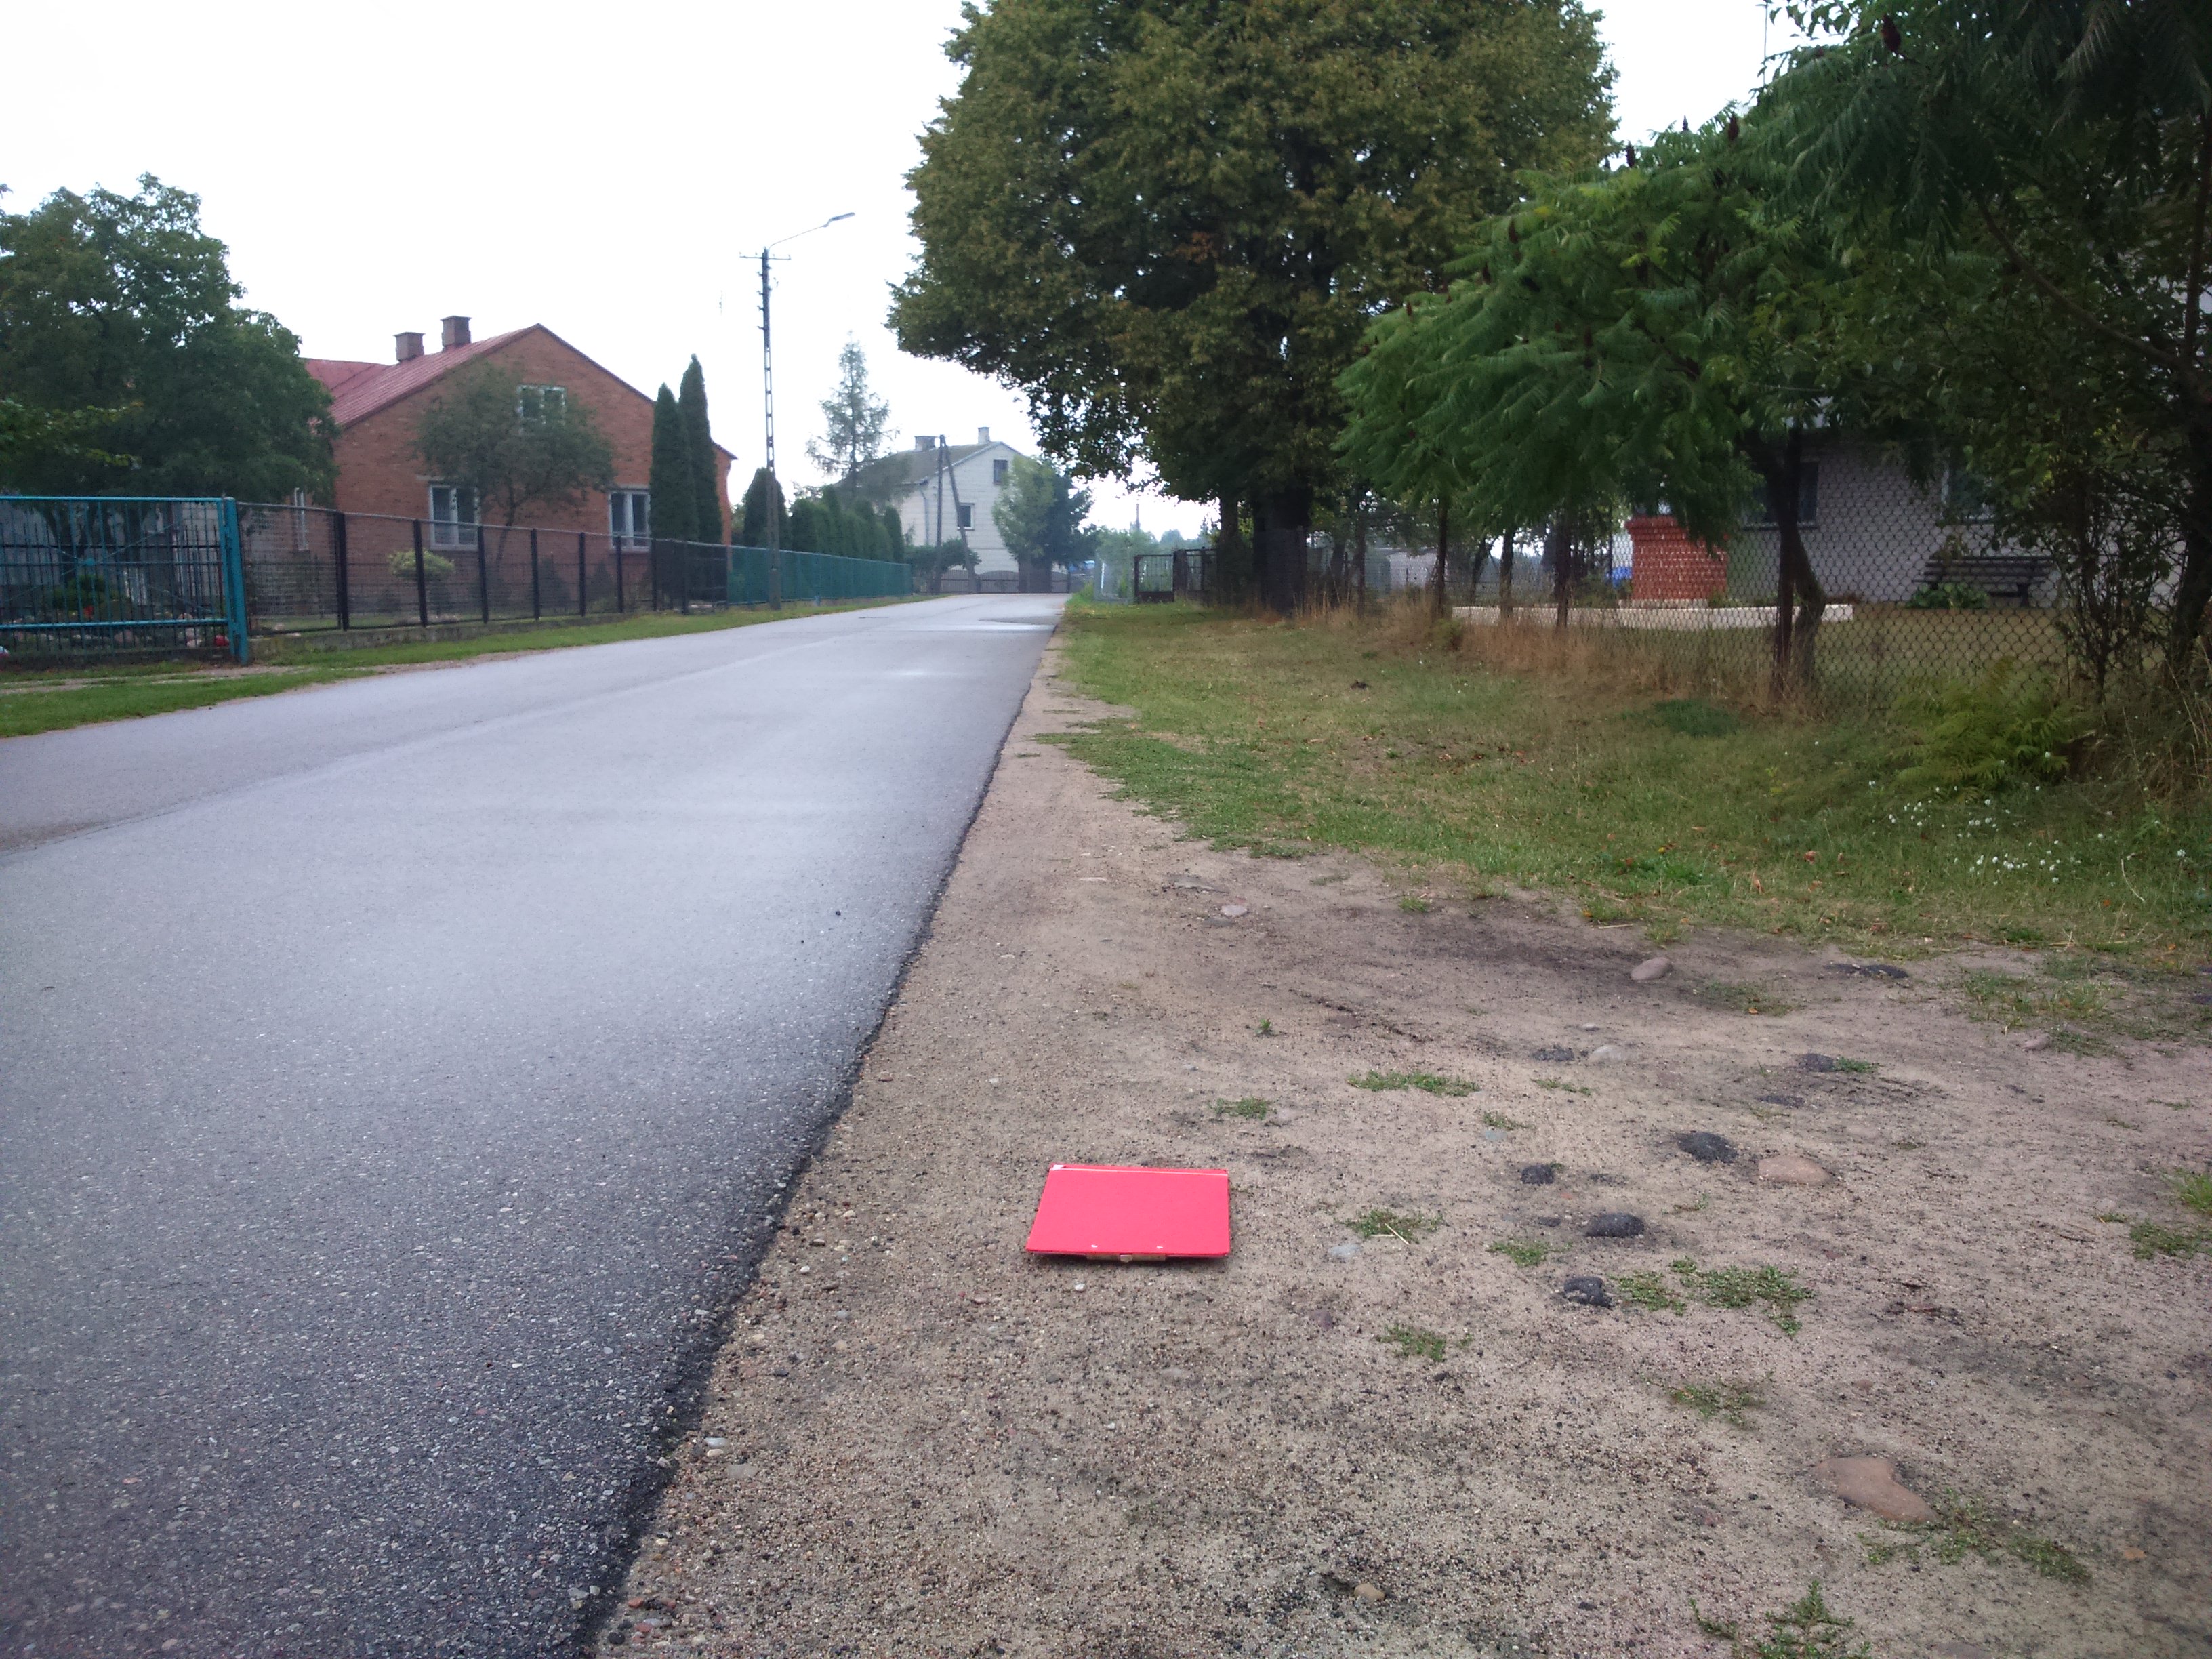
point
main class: Grassland
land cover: Grassland with sparse tree/shrub cover
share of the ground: > 75 %
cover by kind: herbaceous plants 90 %, broadleaved forest trees 5 %, shrubs 5 %
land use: Road transport
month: September
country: PL
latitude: 52.3809
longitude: 22.2111
